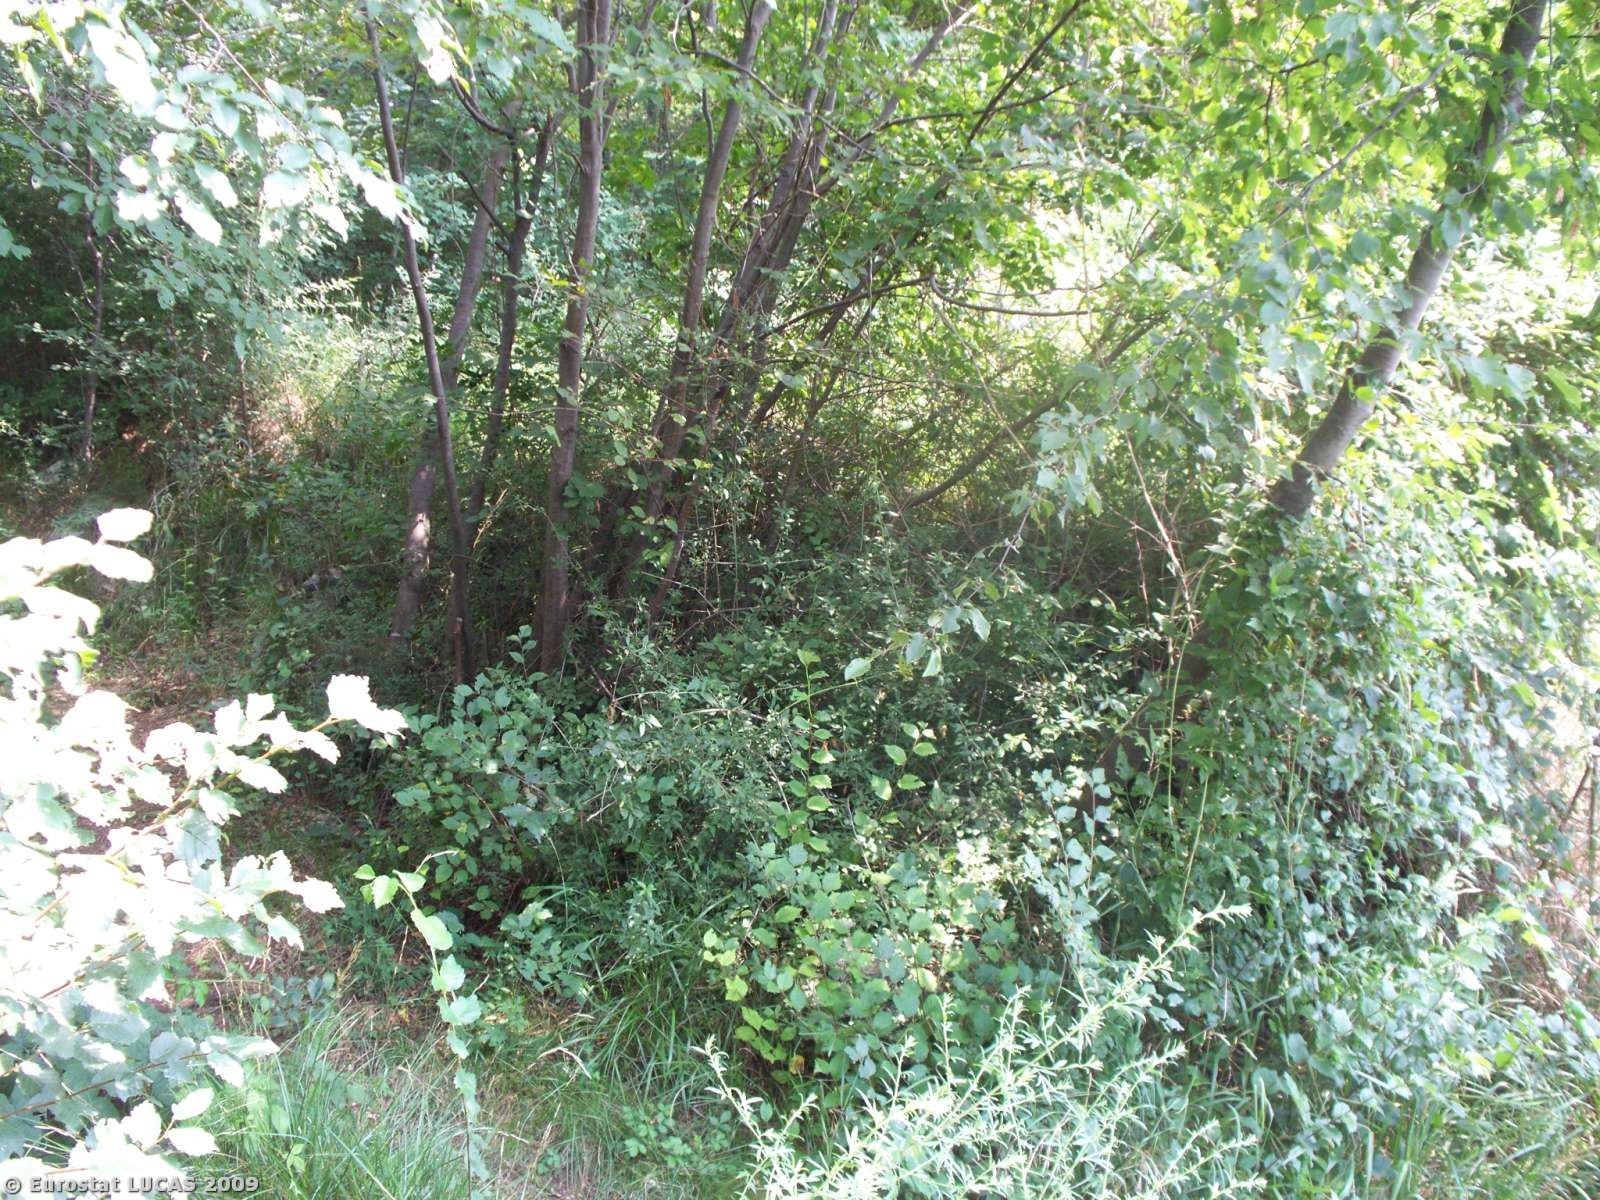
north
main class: Woodland
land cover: Broadleaved woodland
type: mesophytic deciduous forest
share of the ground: > 75 %
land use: Forestry
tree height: > 5 m
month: July
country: IT
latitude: 45.8142
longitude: 11.7605
